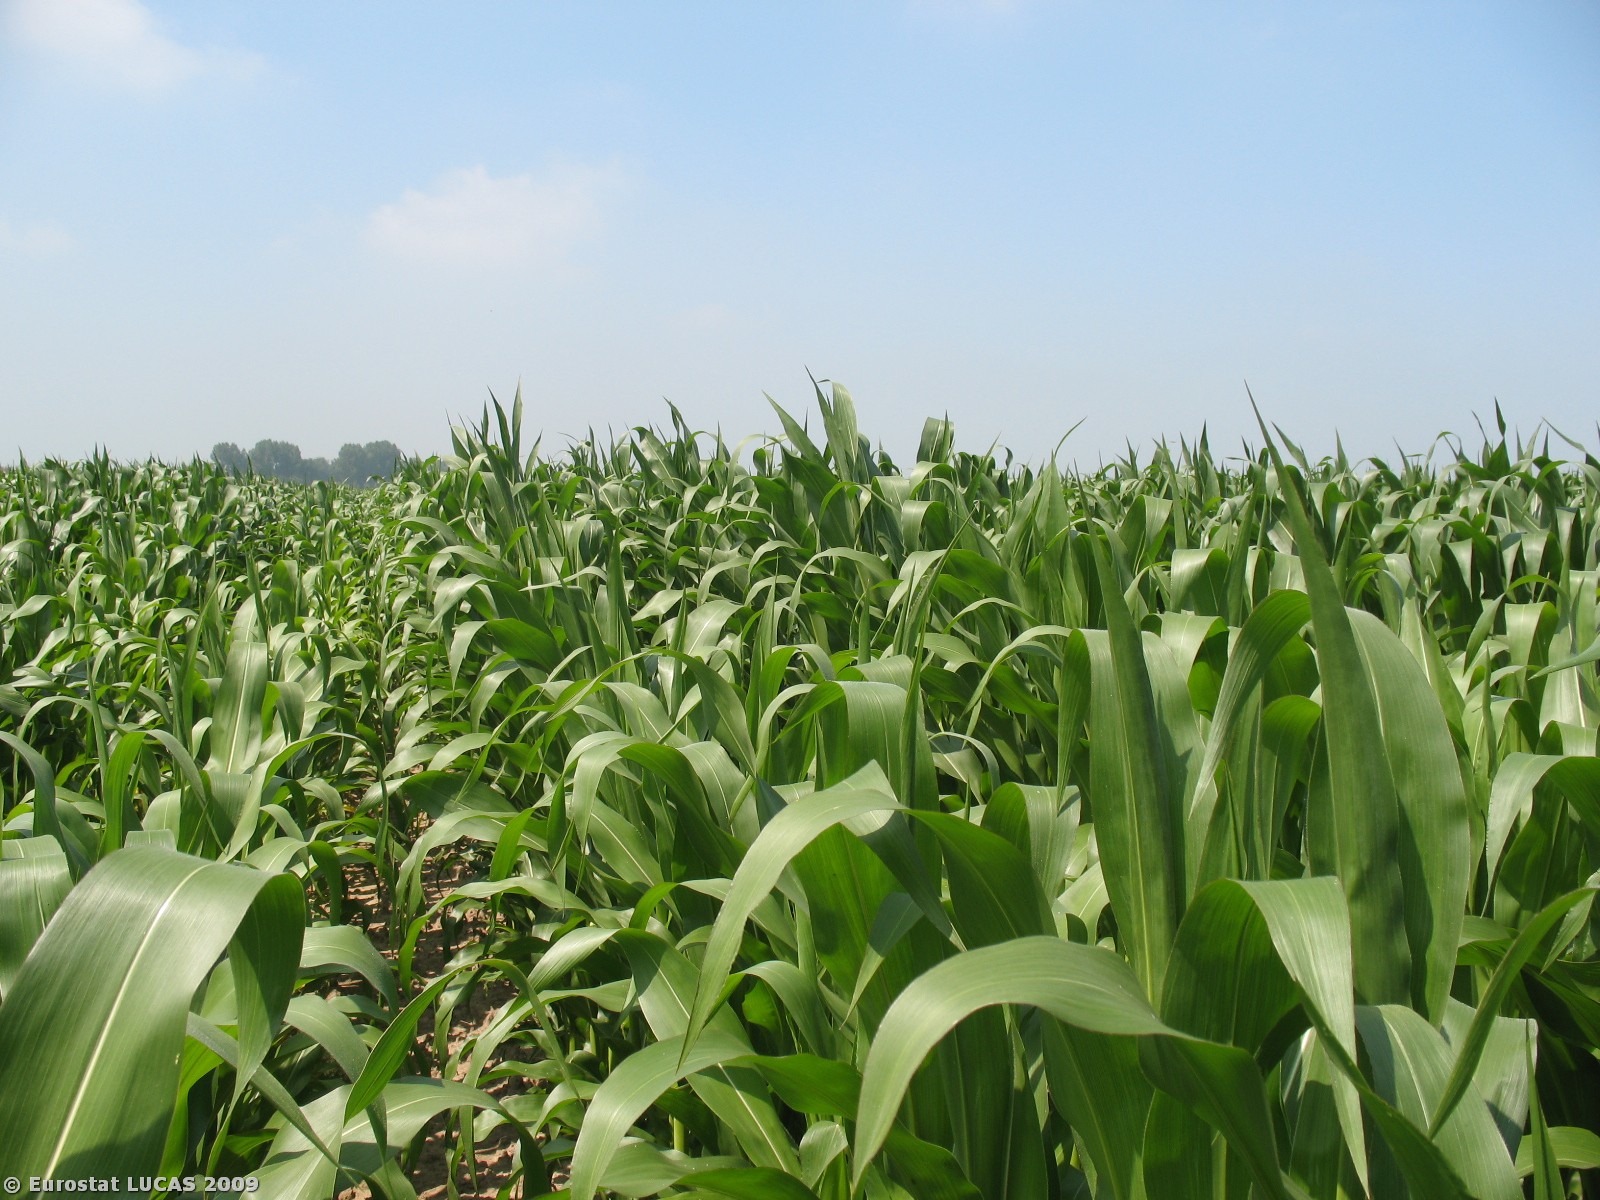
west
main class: Cropland
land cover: Maize
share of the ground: > 75 %
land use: Agriculture (excluding fallow land and kitchen gardens)
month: June
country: BE
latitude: 51.2531
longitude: 3.6742
